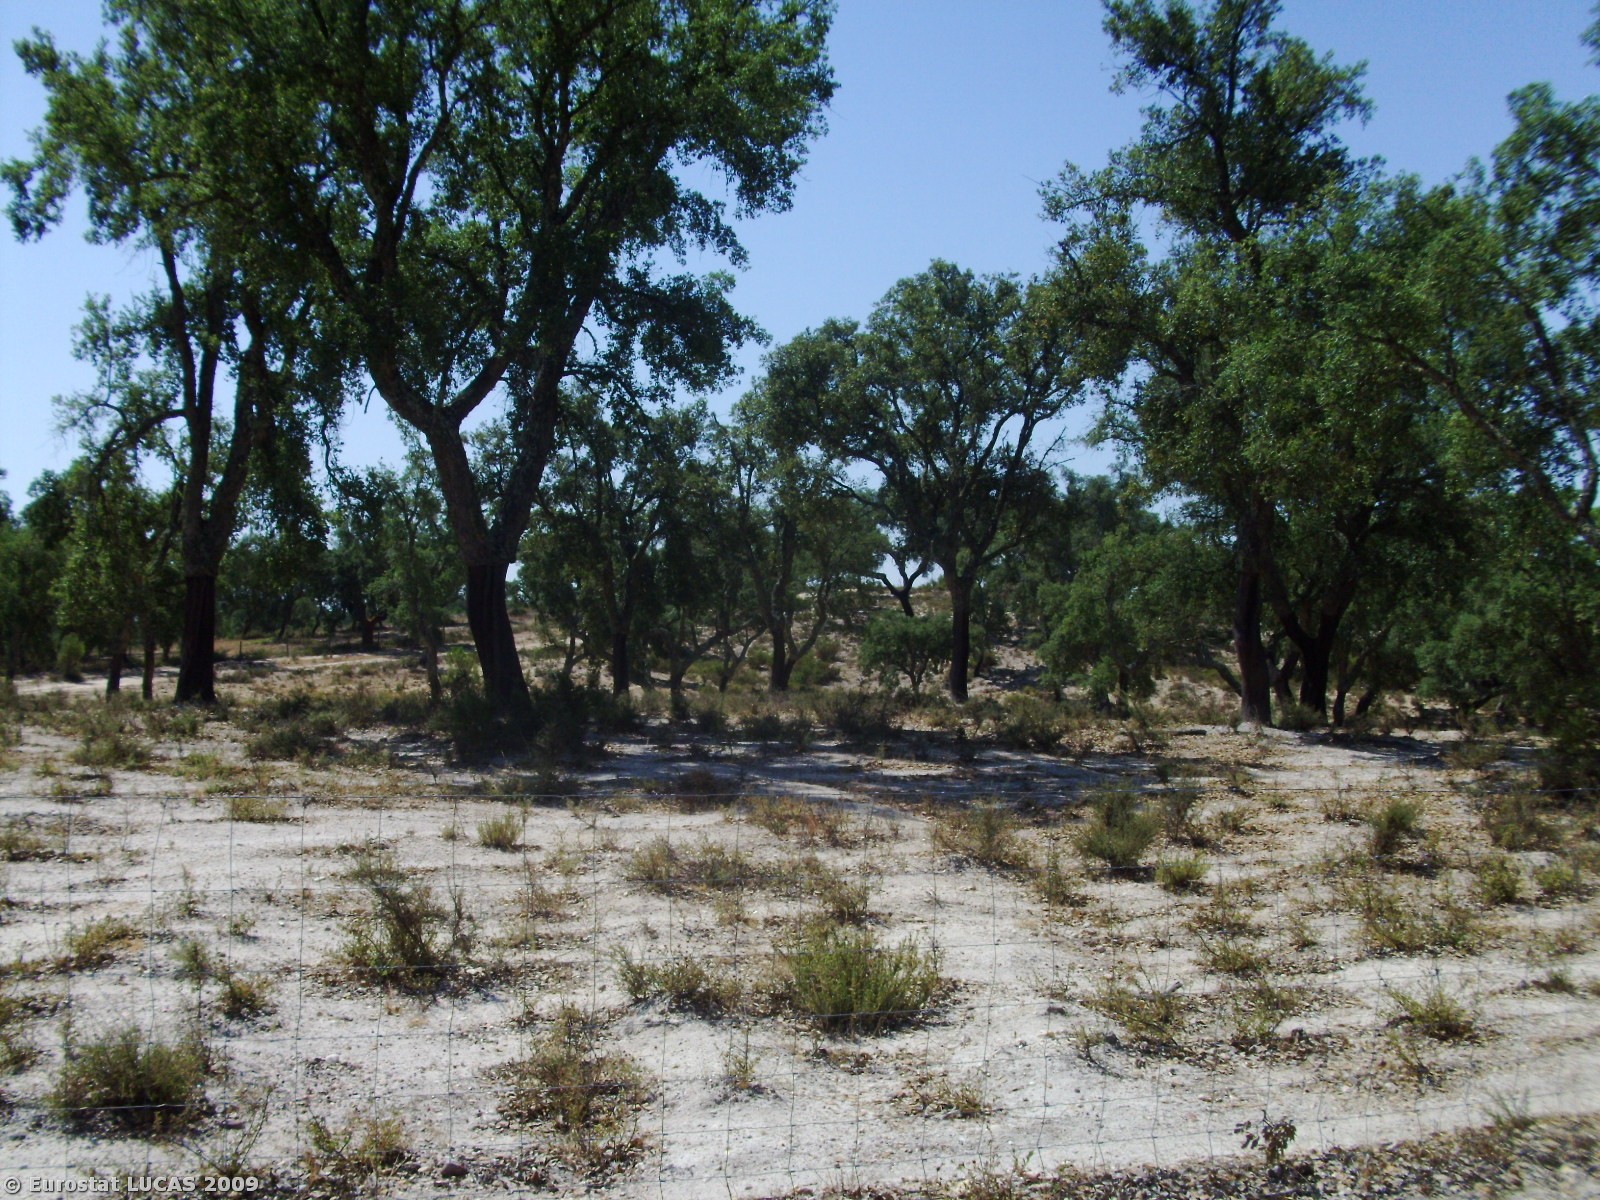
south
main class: Woodland
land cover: Broadleaved woodland
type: broadleaved evergreen forest
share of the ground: 25 - 50 %
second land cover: Bare land
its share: 25 - 50 %
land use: Forestry
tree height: > 5 m
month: August
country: PT
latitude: 39.2563
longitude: -8.0770
